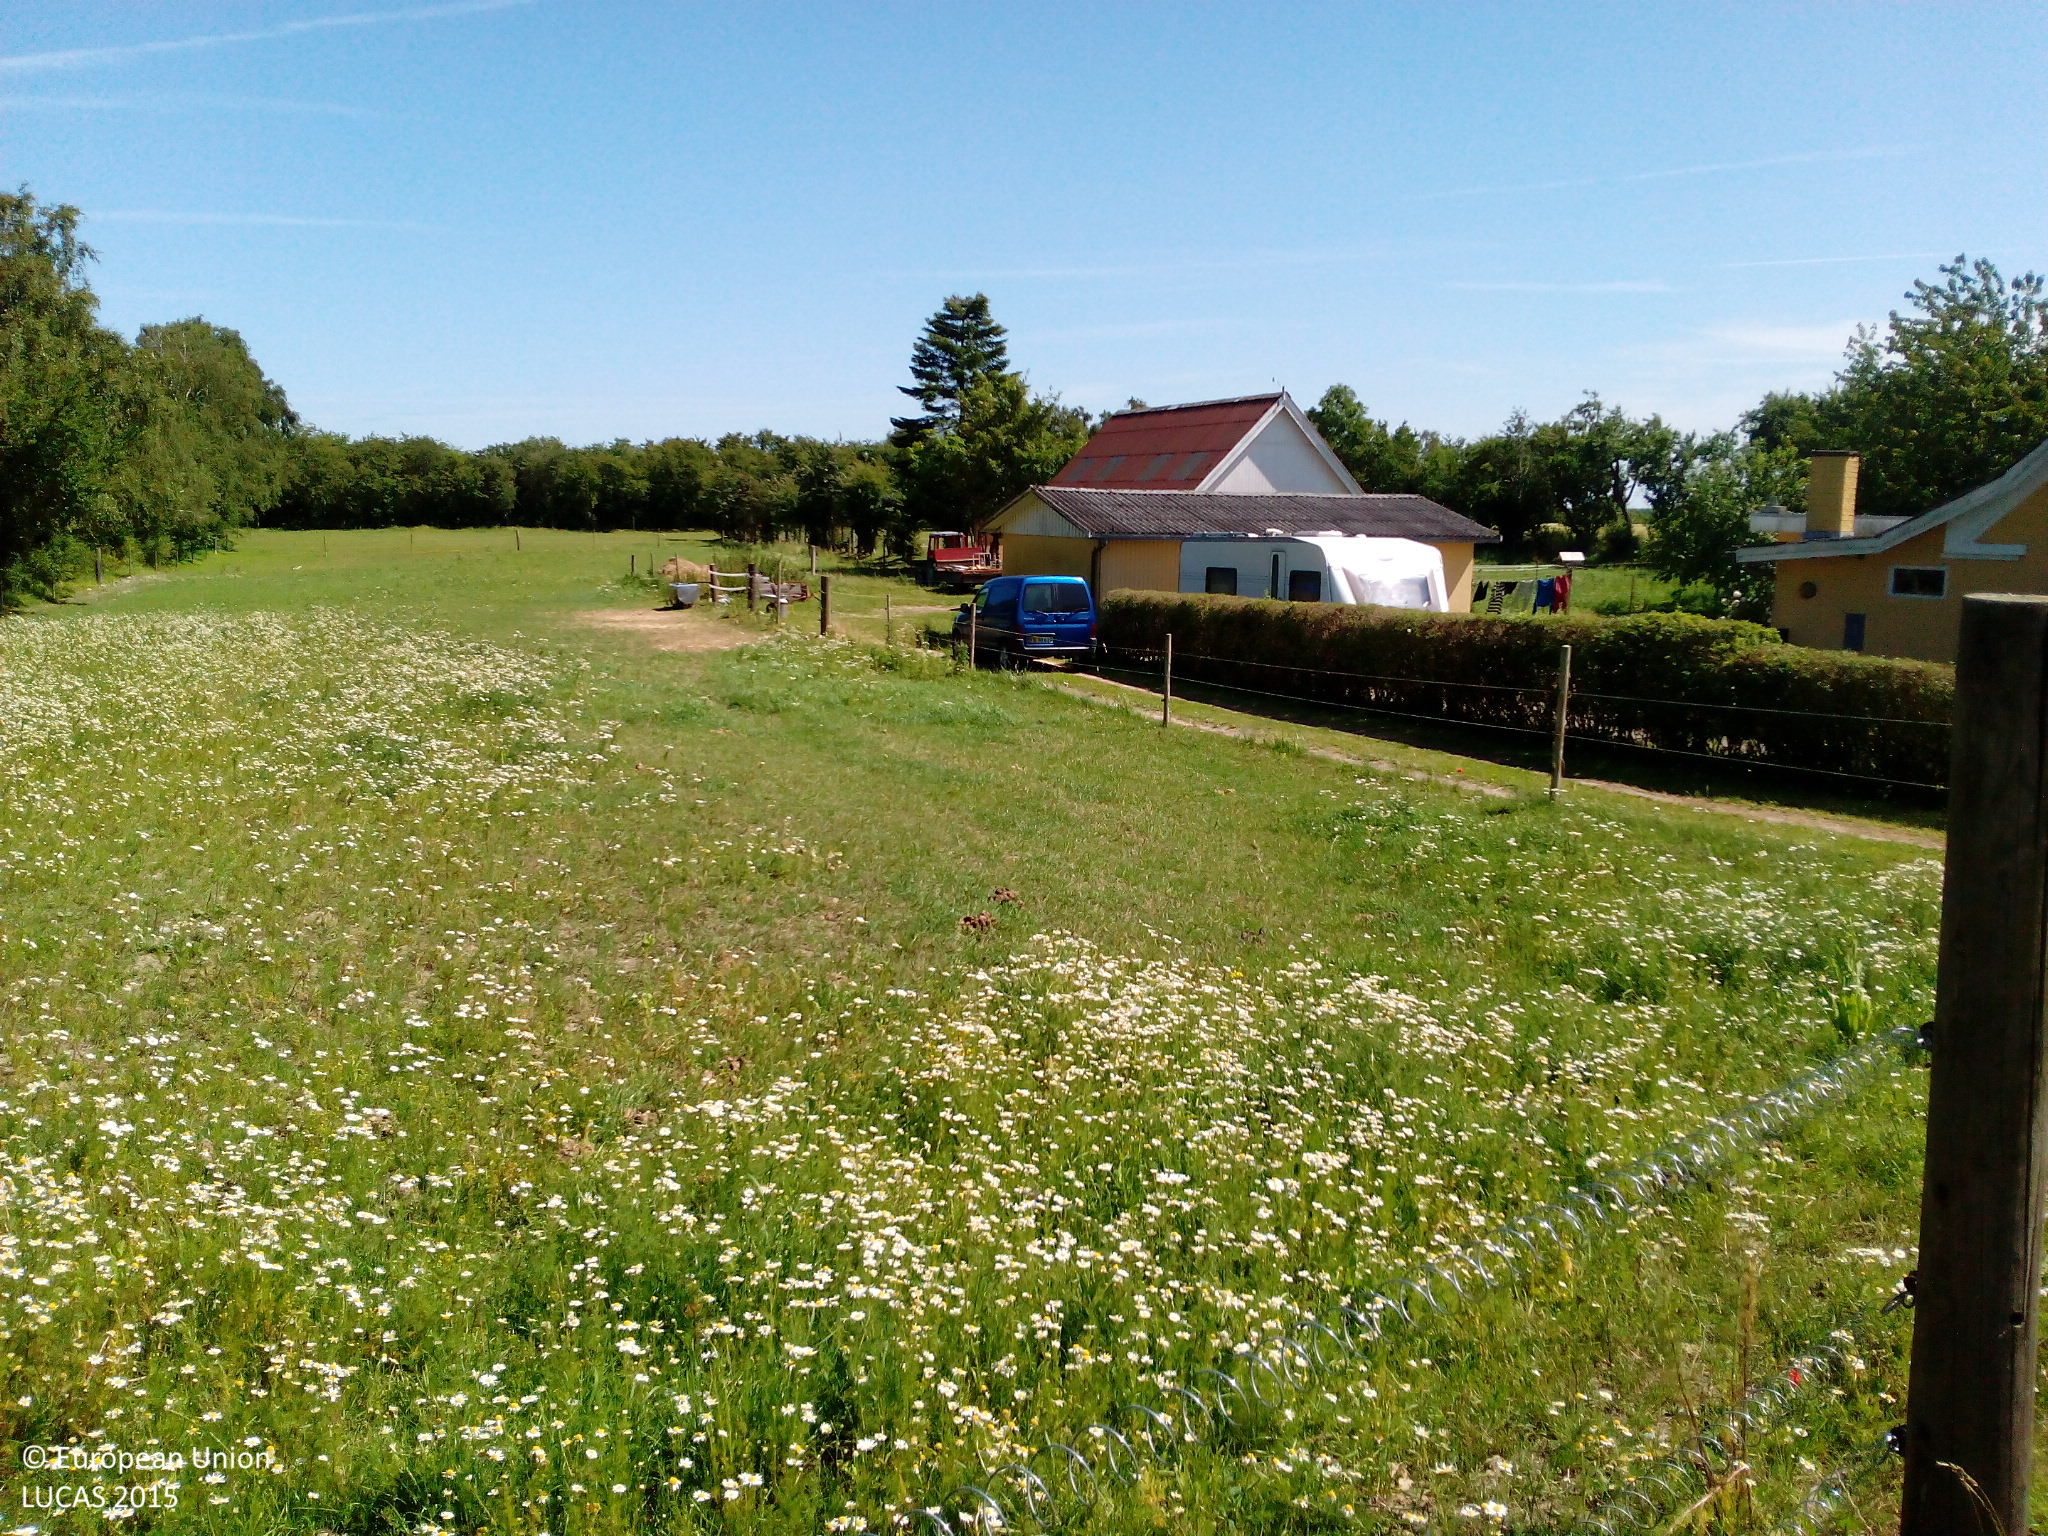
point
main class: Grassland
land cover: Grassland without tree/shrub cover
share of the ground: > 75 %
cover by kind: herbaceous plants 100 %
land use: Agriculture (excluding fallow land and kitchen gardens)
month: July
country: DK
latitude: 55.4763
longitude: 11.6282
